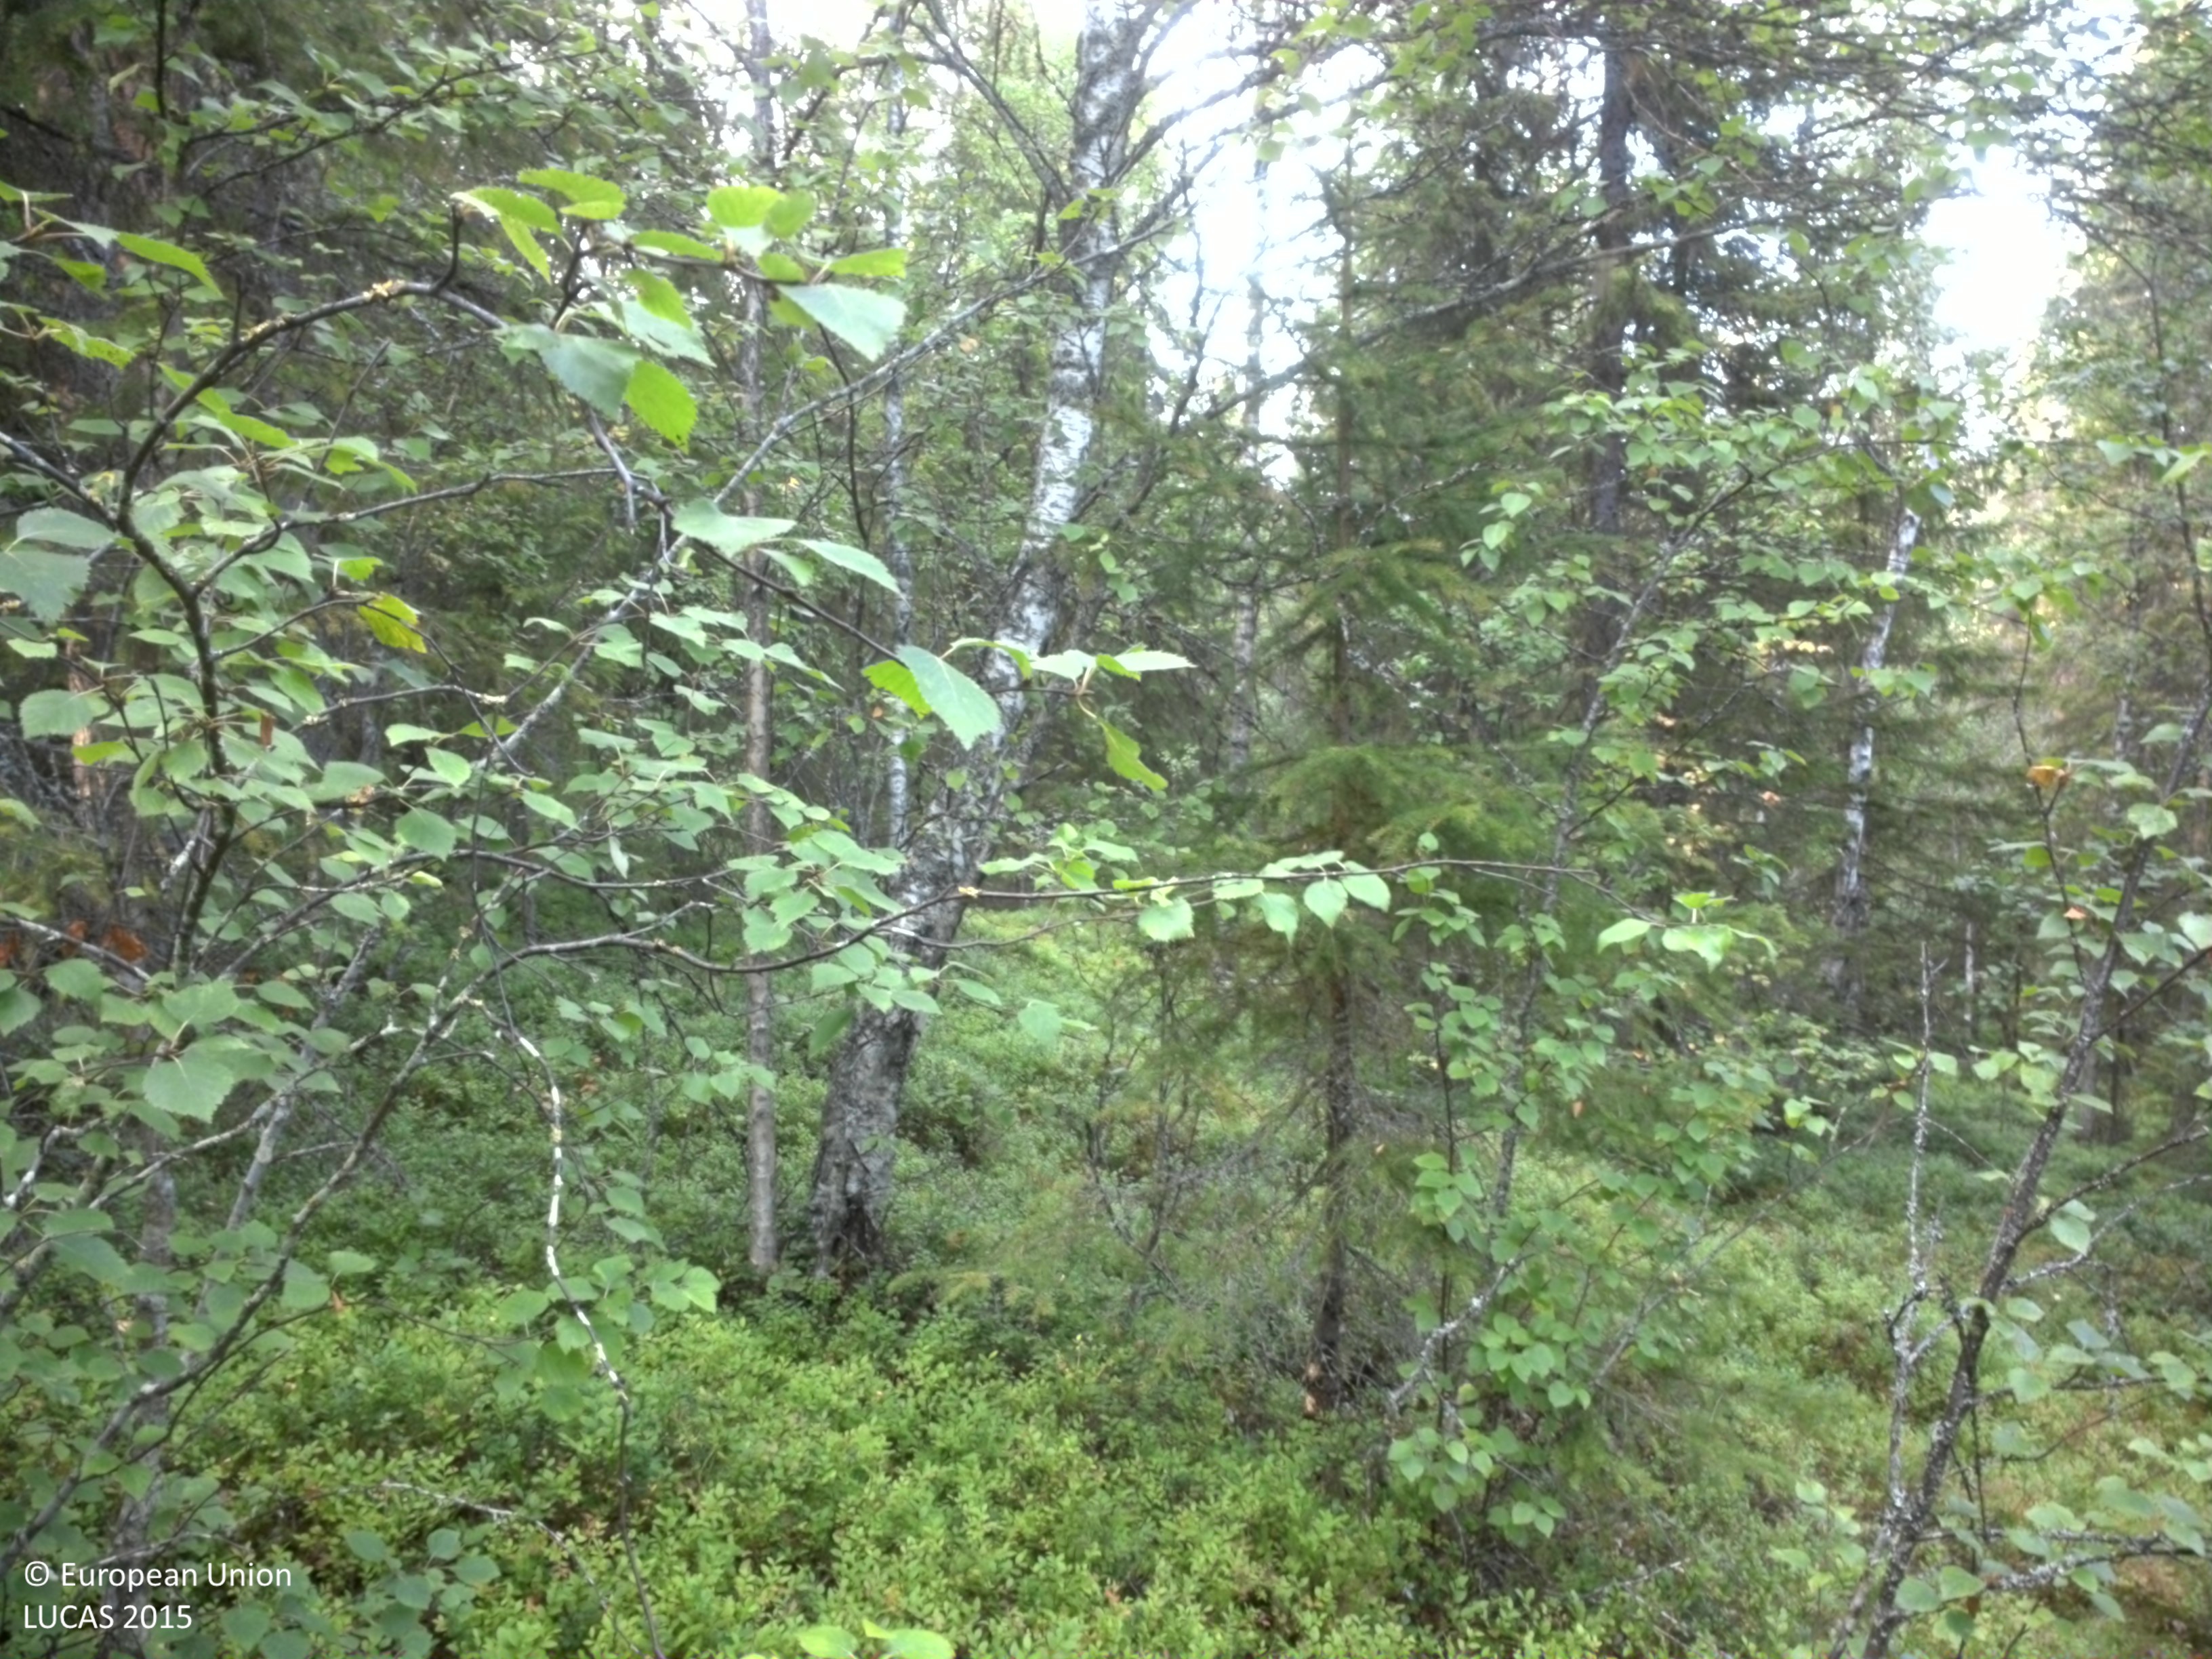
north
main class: Woodland
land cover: Spruce dominated mixed woodland
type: boreal forest
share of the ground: 50 - 75 %
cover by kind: coniferous forest trees 45 %, shrubs 40 %, broadleaved forest trees 15 %
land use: Forestry
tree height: > 5 m
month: August
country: SE
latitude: 64.5341
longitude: 18.8278
